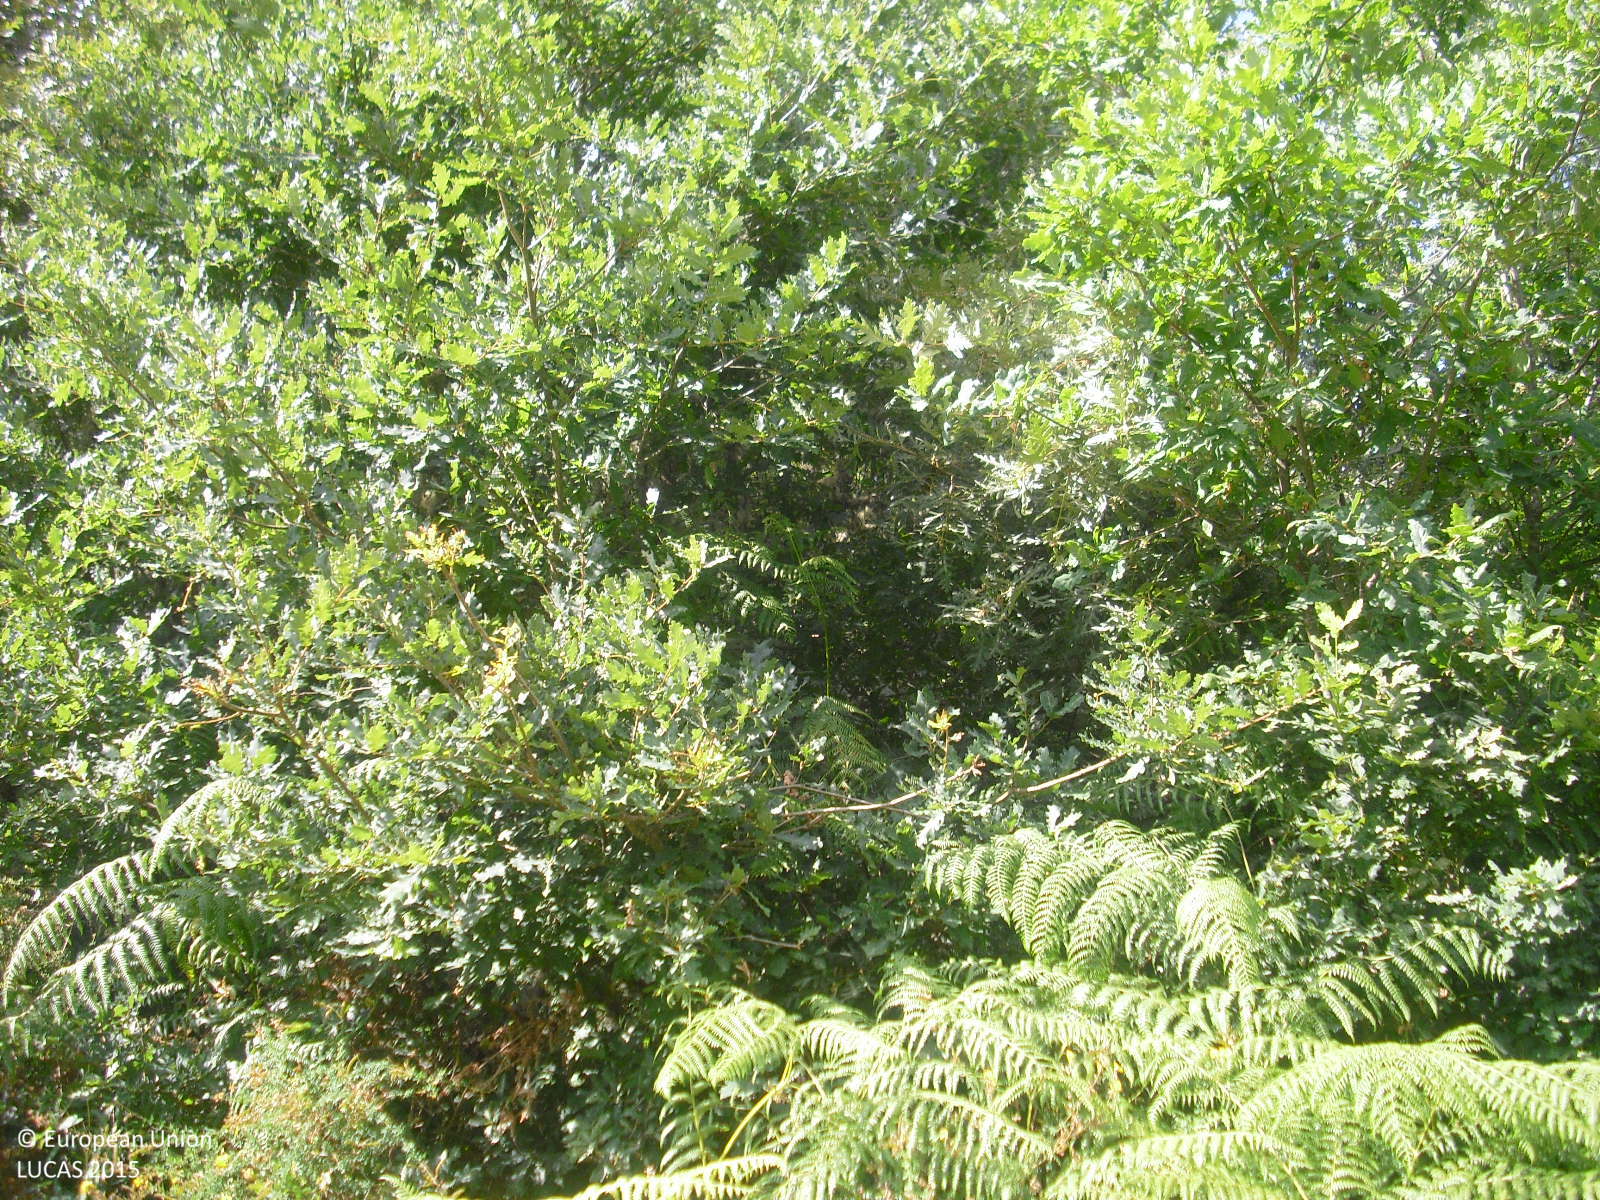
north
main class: Woodland
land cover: Broadleaved woodland
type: thermophilous deciduous forest
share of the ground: 50 - 75 %
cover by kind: broadleaved forest trees 60 %, shrubs 30 %, herbaceous plants 10 %
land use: Forestry
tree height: > 5 m
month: July
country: ES
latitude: 42.3376
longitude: -7.6830
